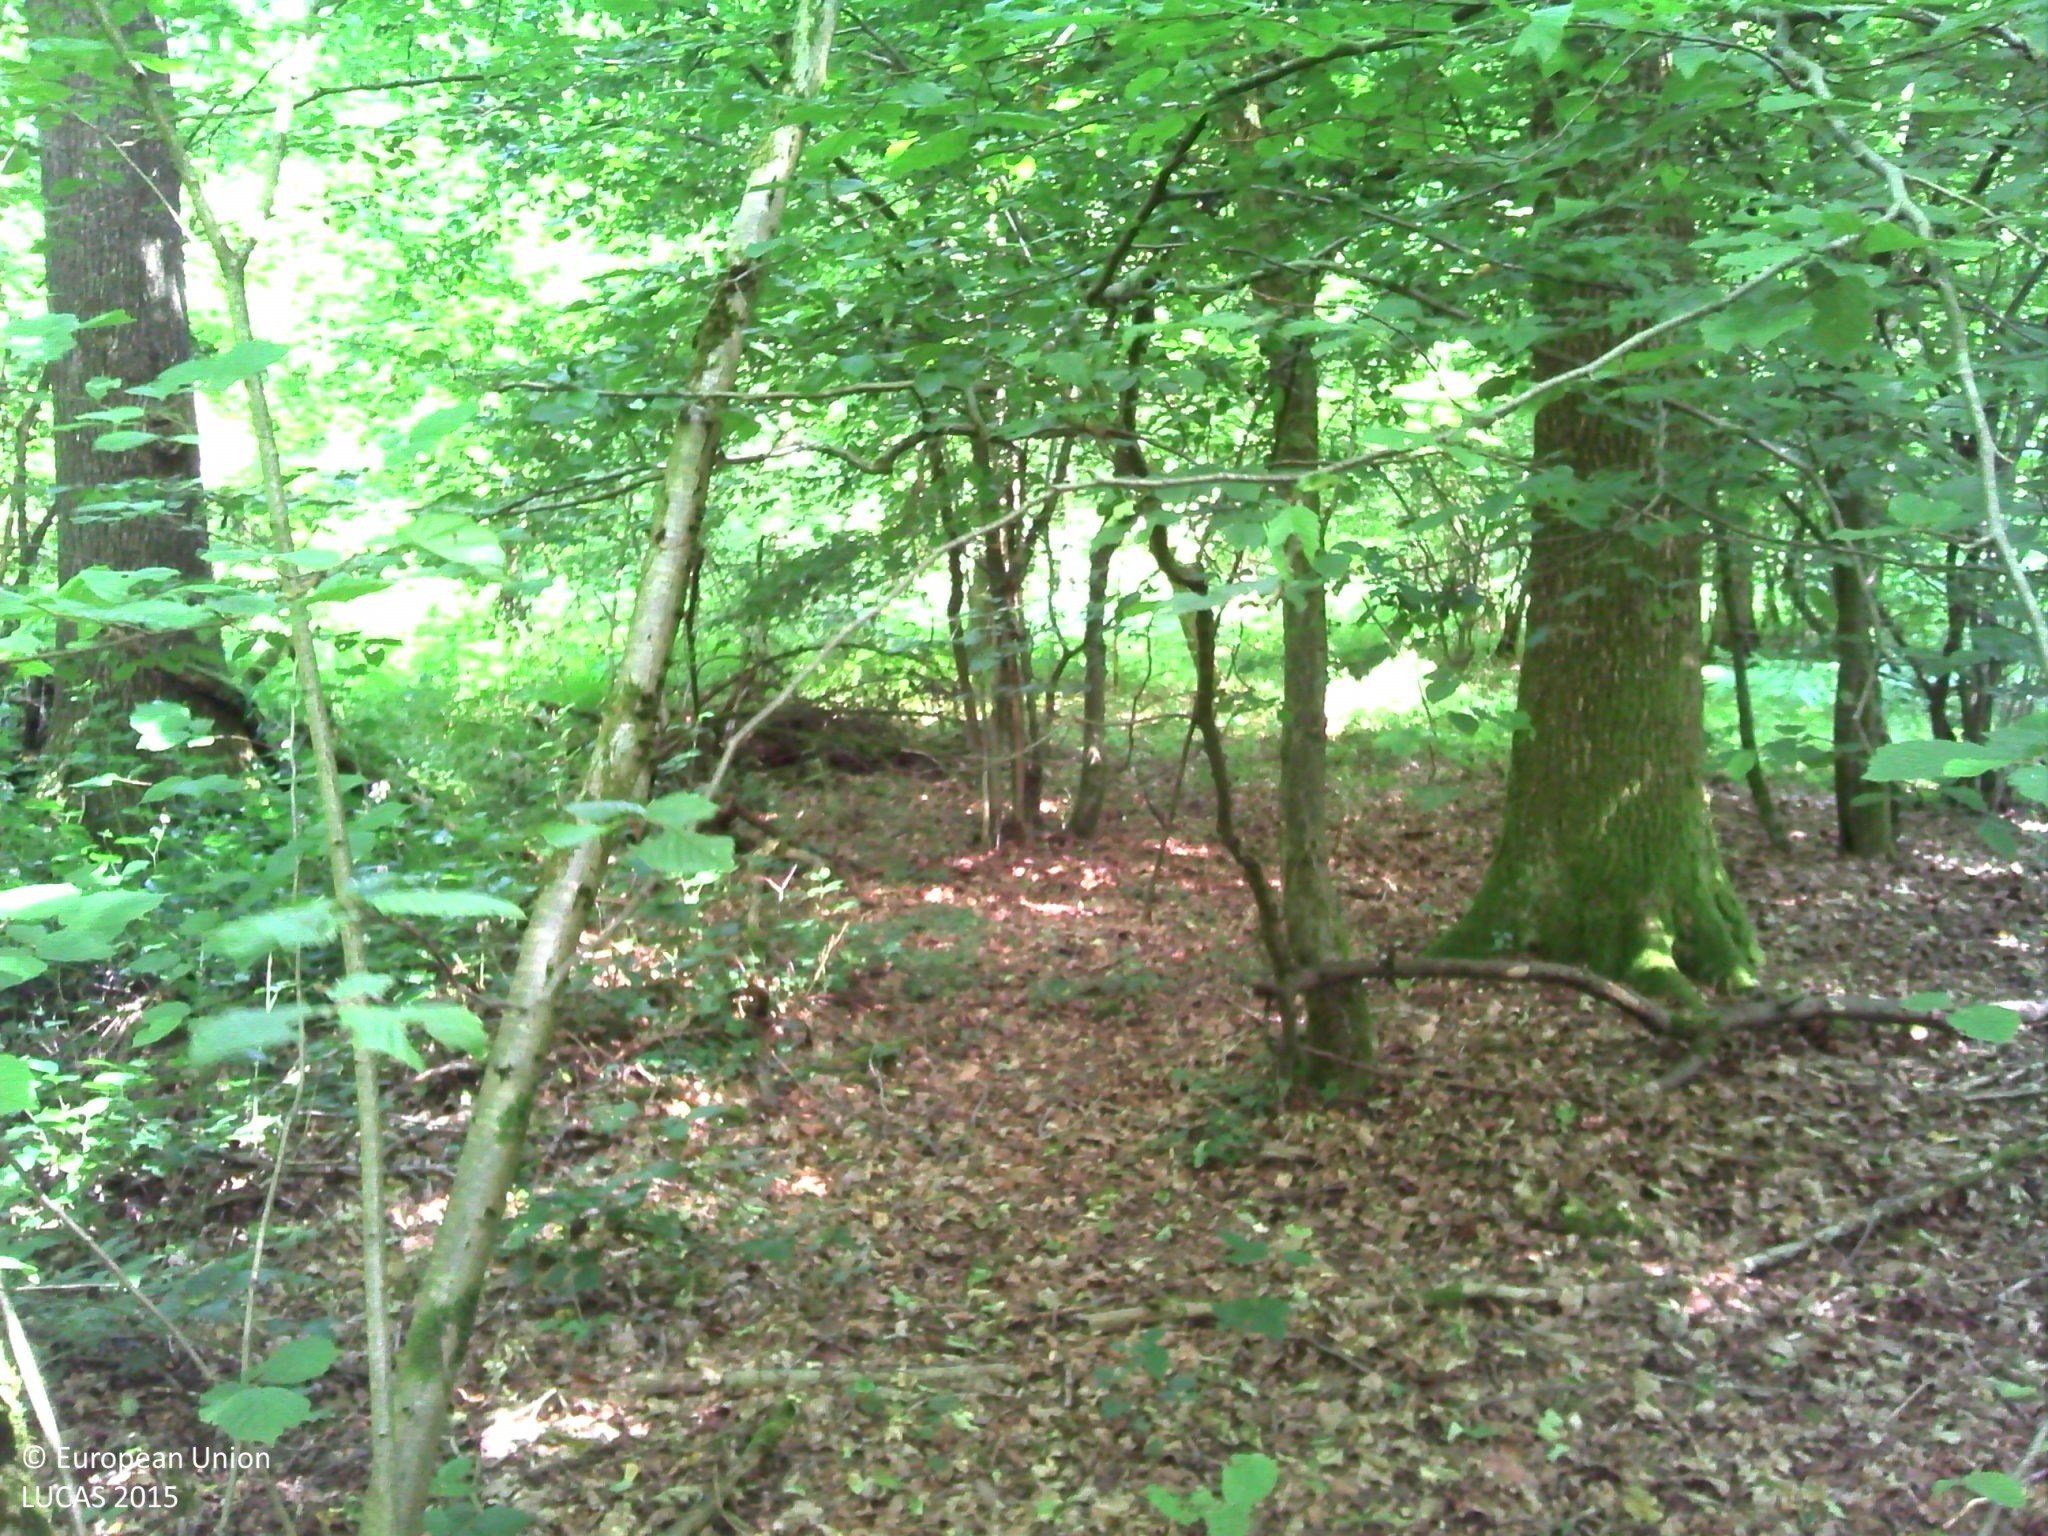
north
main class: Woodland
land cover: Broadleaved woodland
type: mesophytic deciduous forest
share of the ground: > 75 %
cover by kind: broadleaved forest trees 95 %, herbaceous plants 5 %
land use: Forestry
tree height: > 5 m
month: July
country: BE
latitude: 50.2172
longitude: 4.5725
